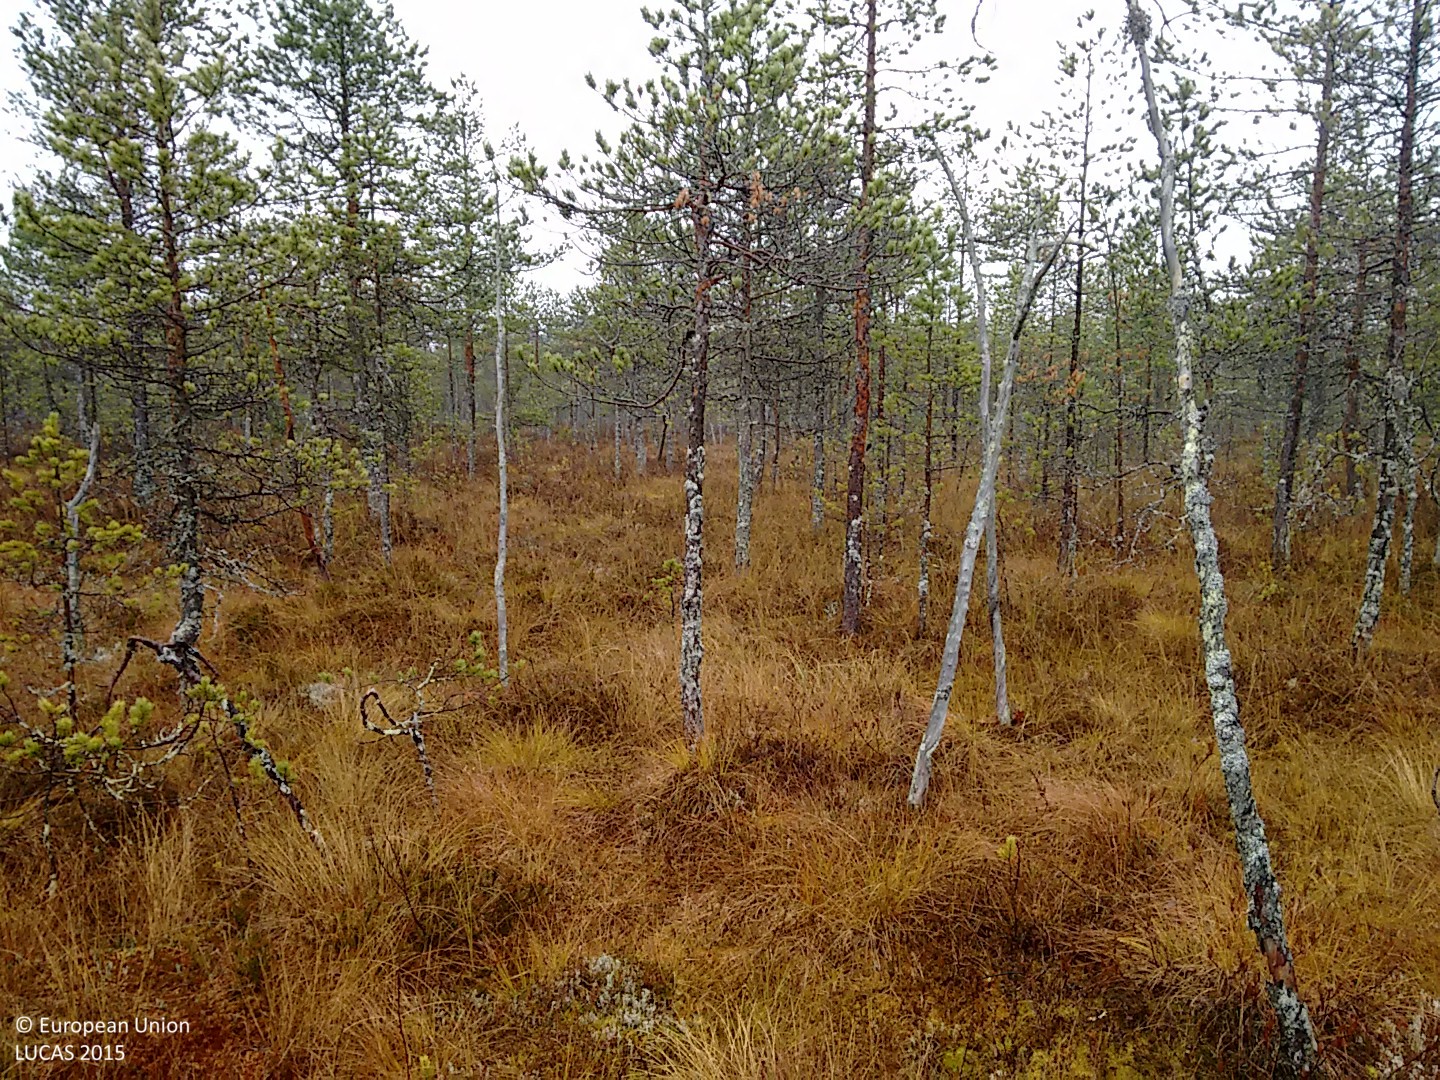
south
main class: Woodland
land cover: Pine dominated coniferous woodland
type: mire and swamp forests
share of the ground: 50 - 75 %
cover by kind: coniferous forest trees 55 %, shrubs 20 %, herbaceous plants 20 %, lichens and mosses 5 %
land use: Semi-natural and natural areas not in use
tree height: < 5 m
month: October
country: FI
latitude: 64.5382
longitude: 24.8992
